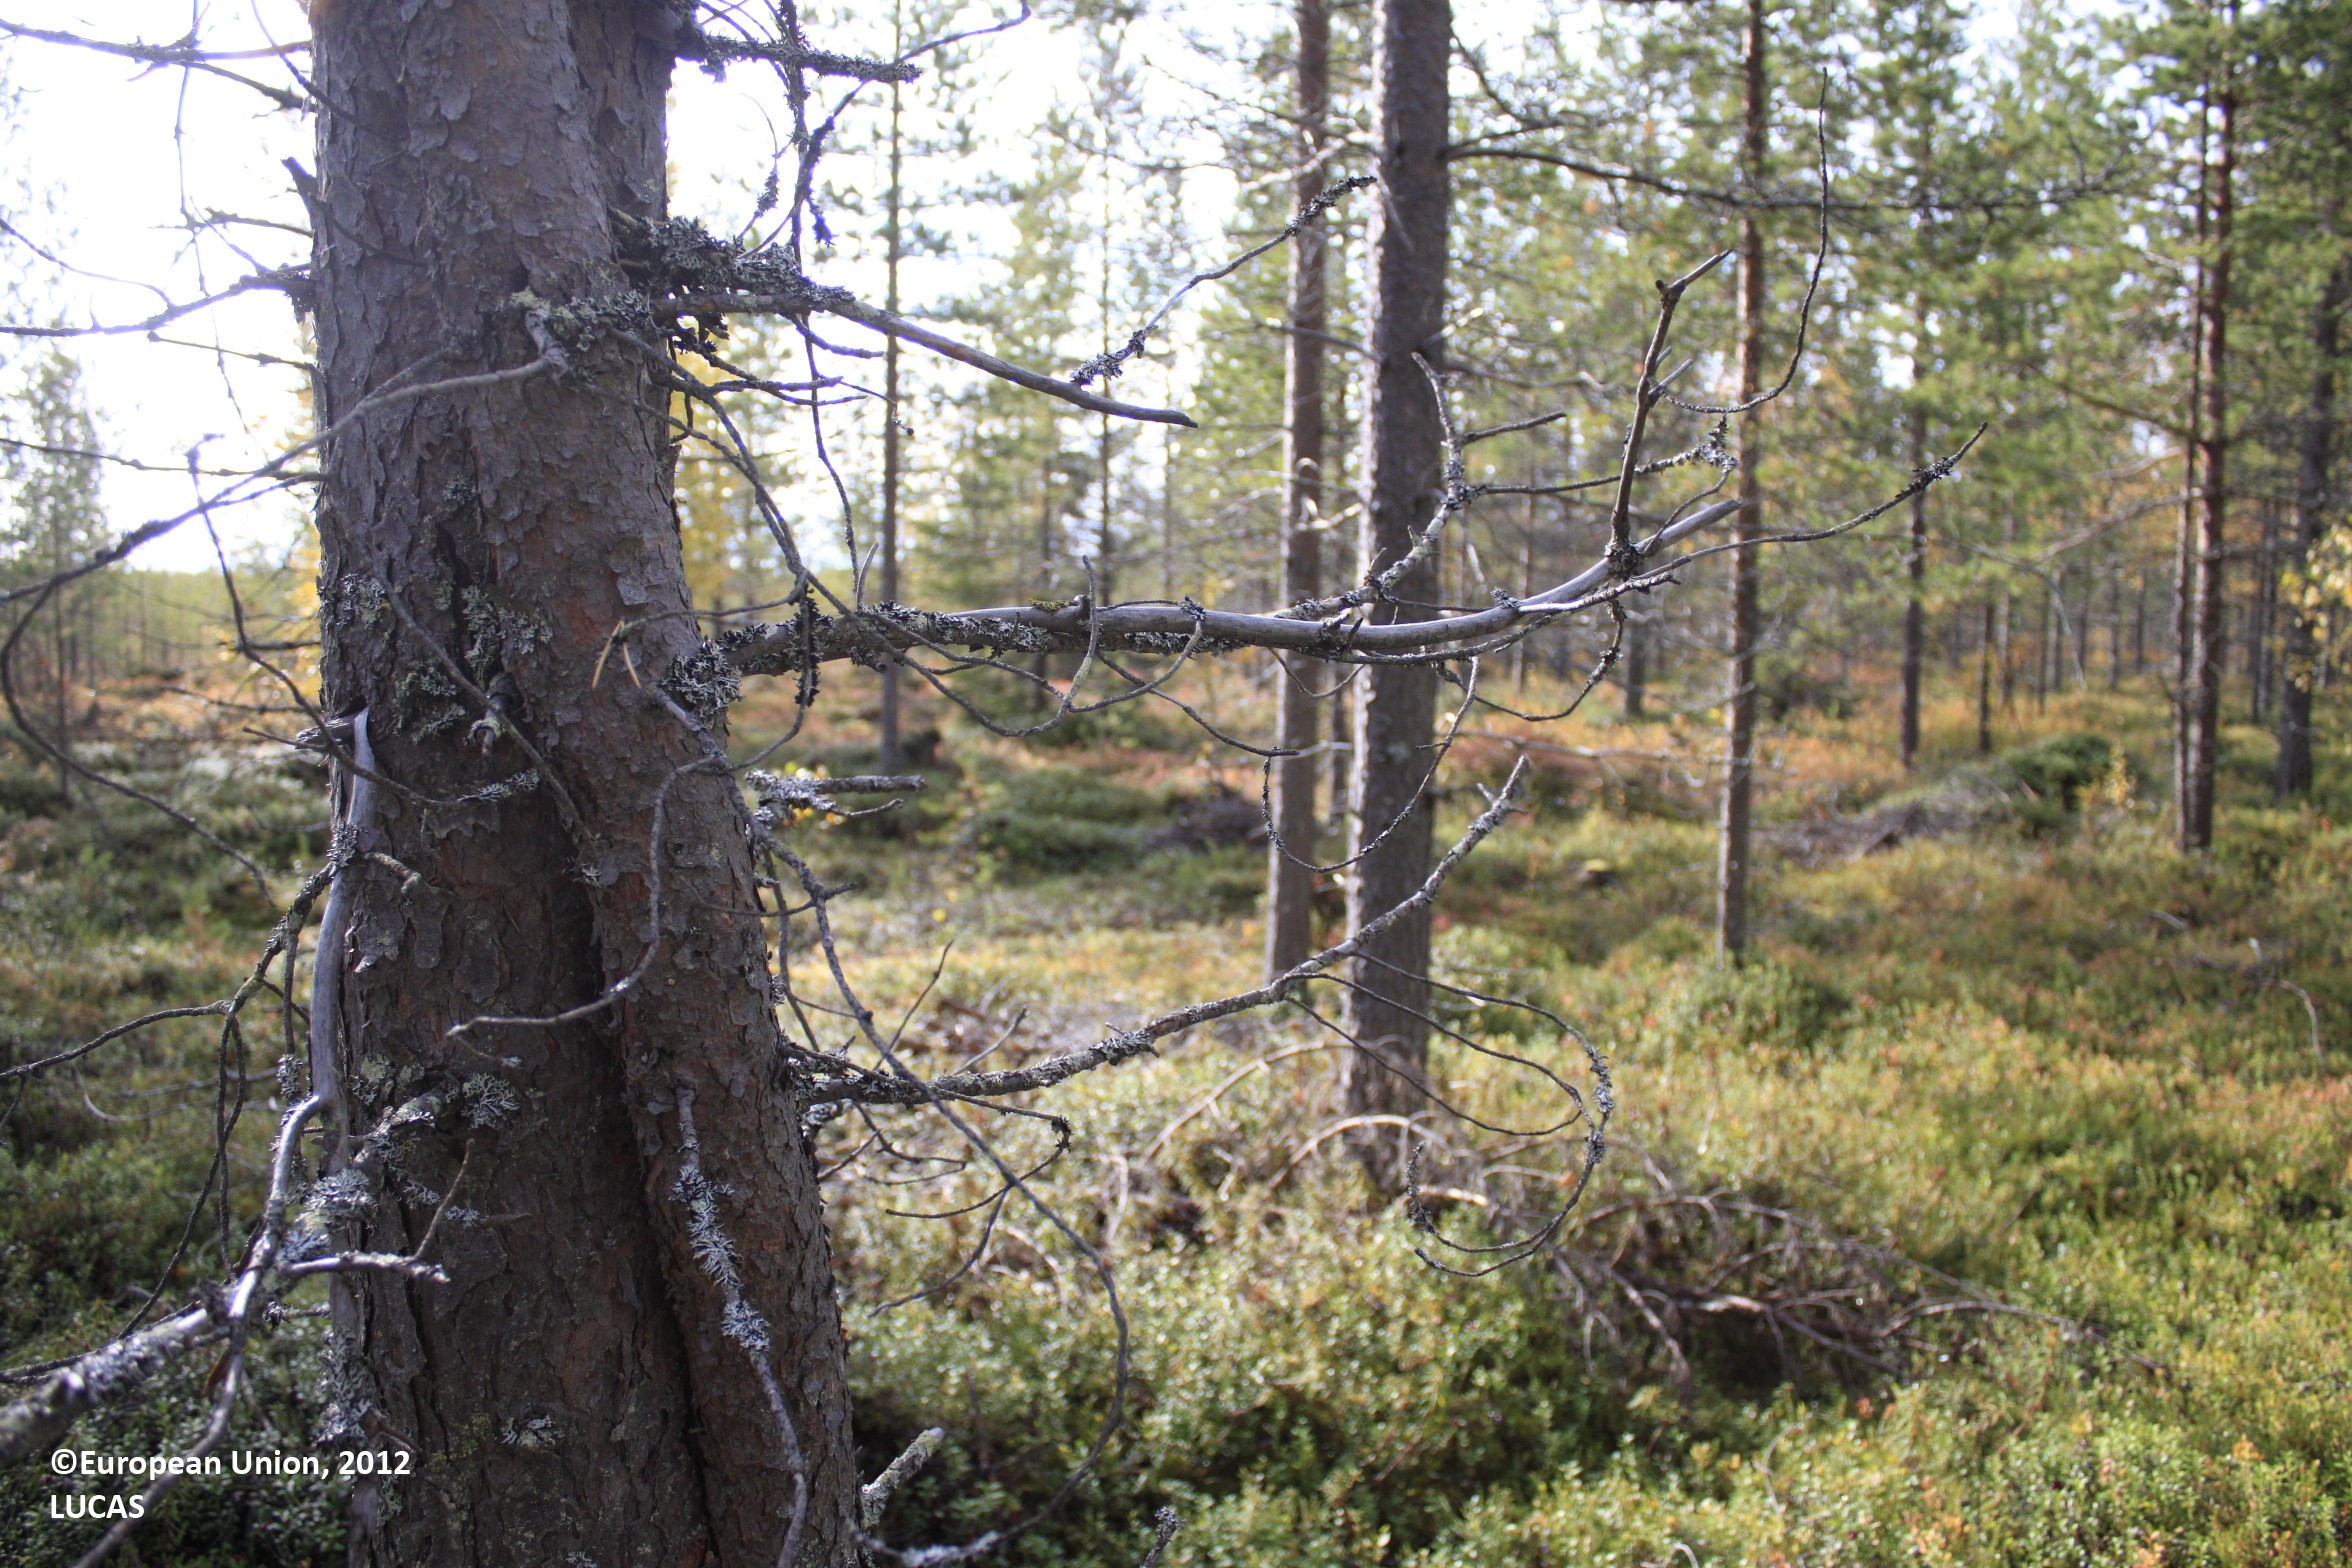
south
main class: Woodland
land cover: Pine dominated coniferous woodland
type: boreal forest
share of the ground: 25 - 50 %
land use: Forestry
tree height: > 5 m
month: September
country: FI
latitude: 66.0070
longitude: 27.2842
